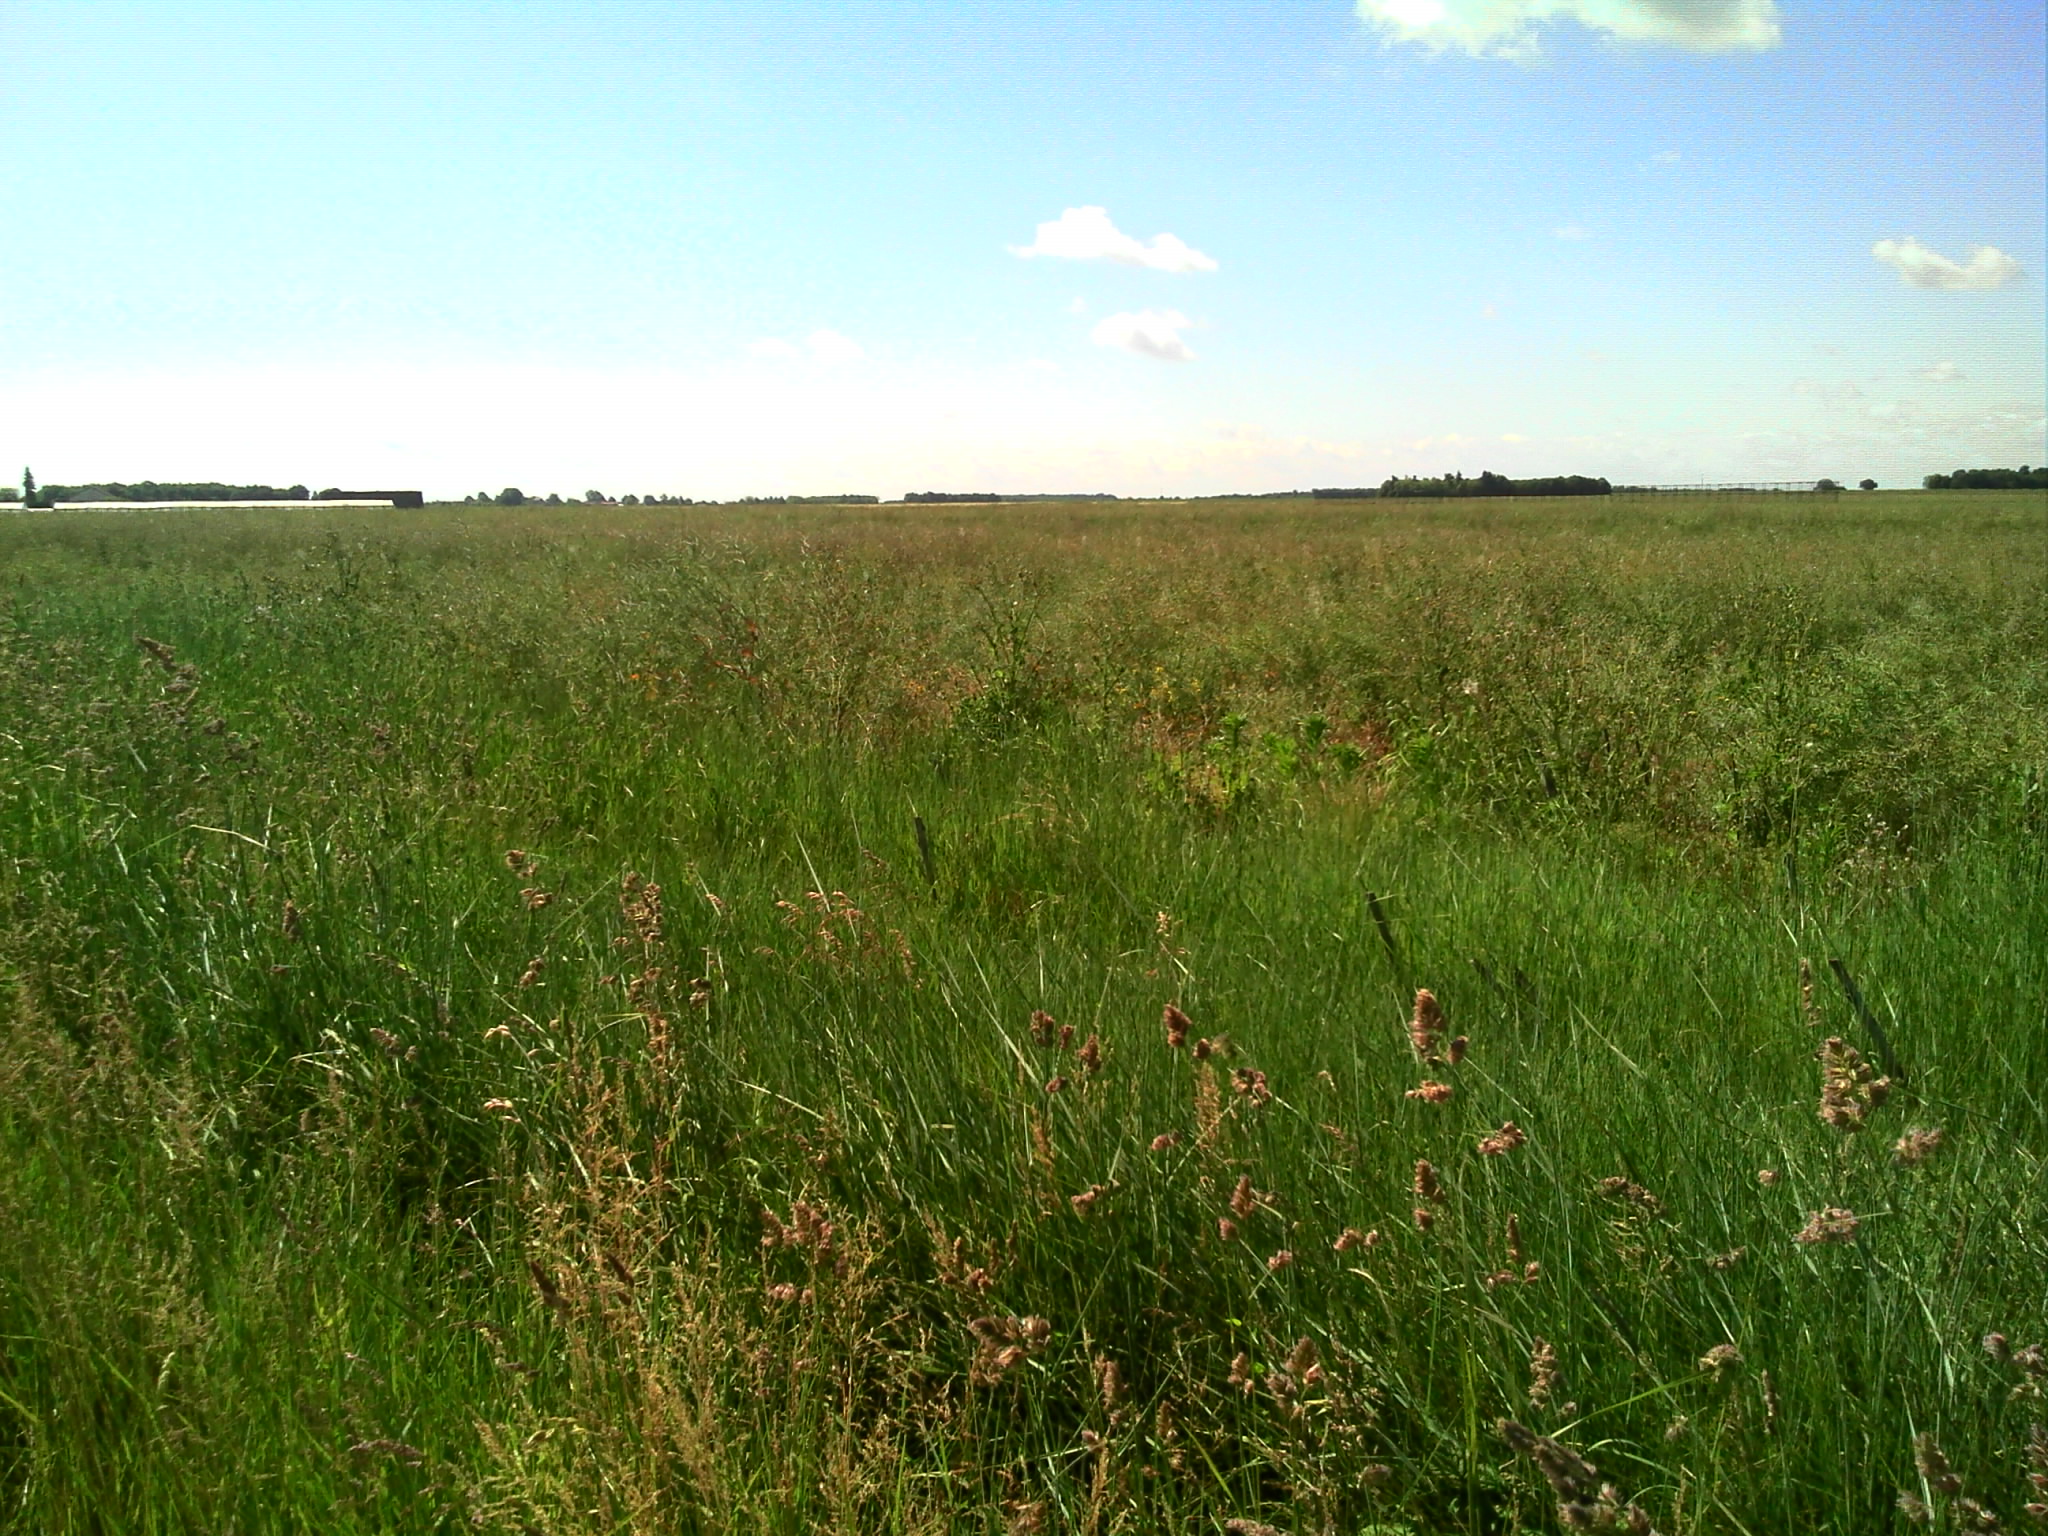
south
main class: Cropland
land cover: Rape and turnip rape
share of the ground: > 75 %
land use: Agriculture (excluding fallow land and kitchen gardens)
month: May
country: FR
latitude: 47.0247
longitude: 0.2020
